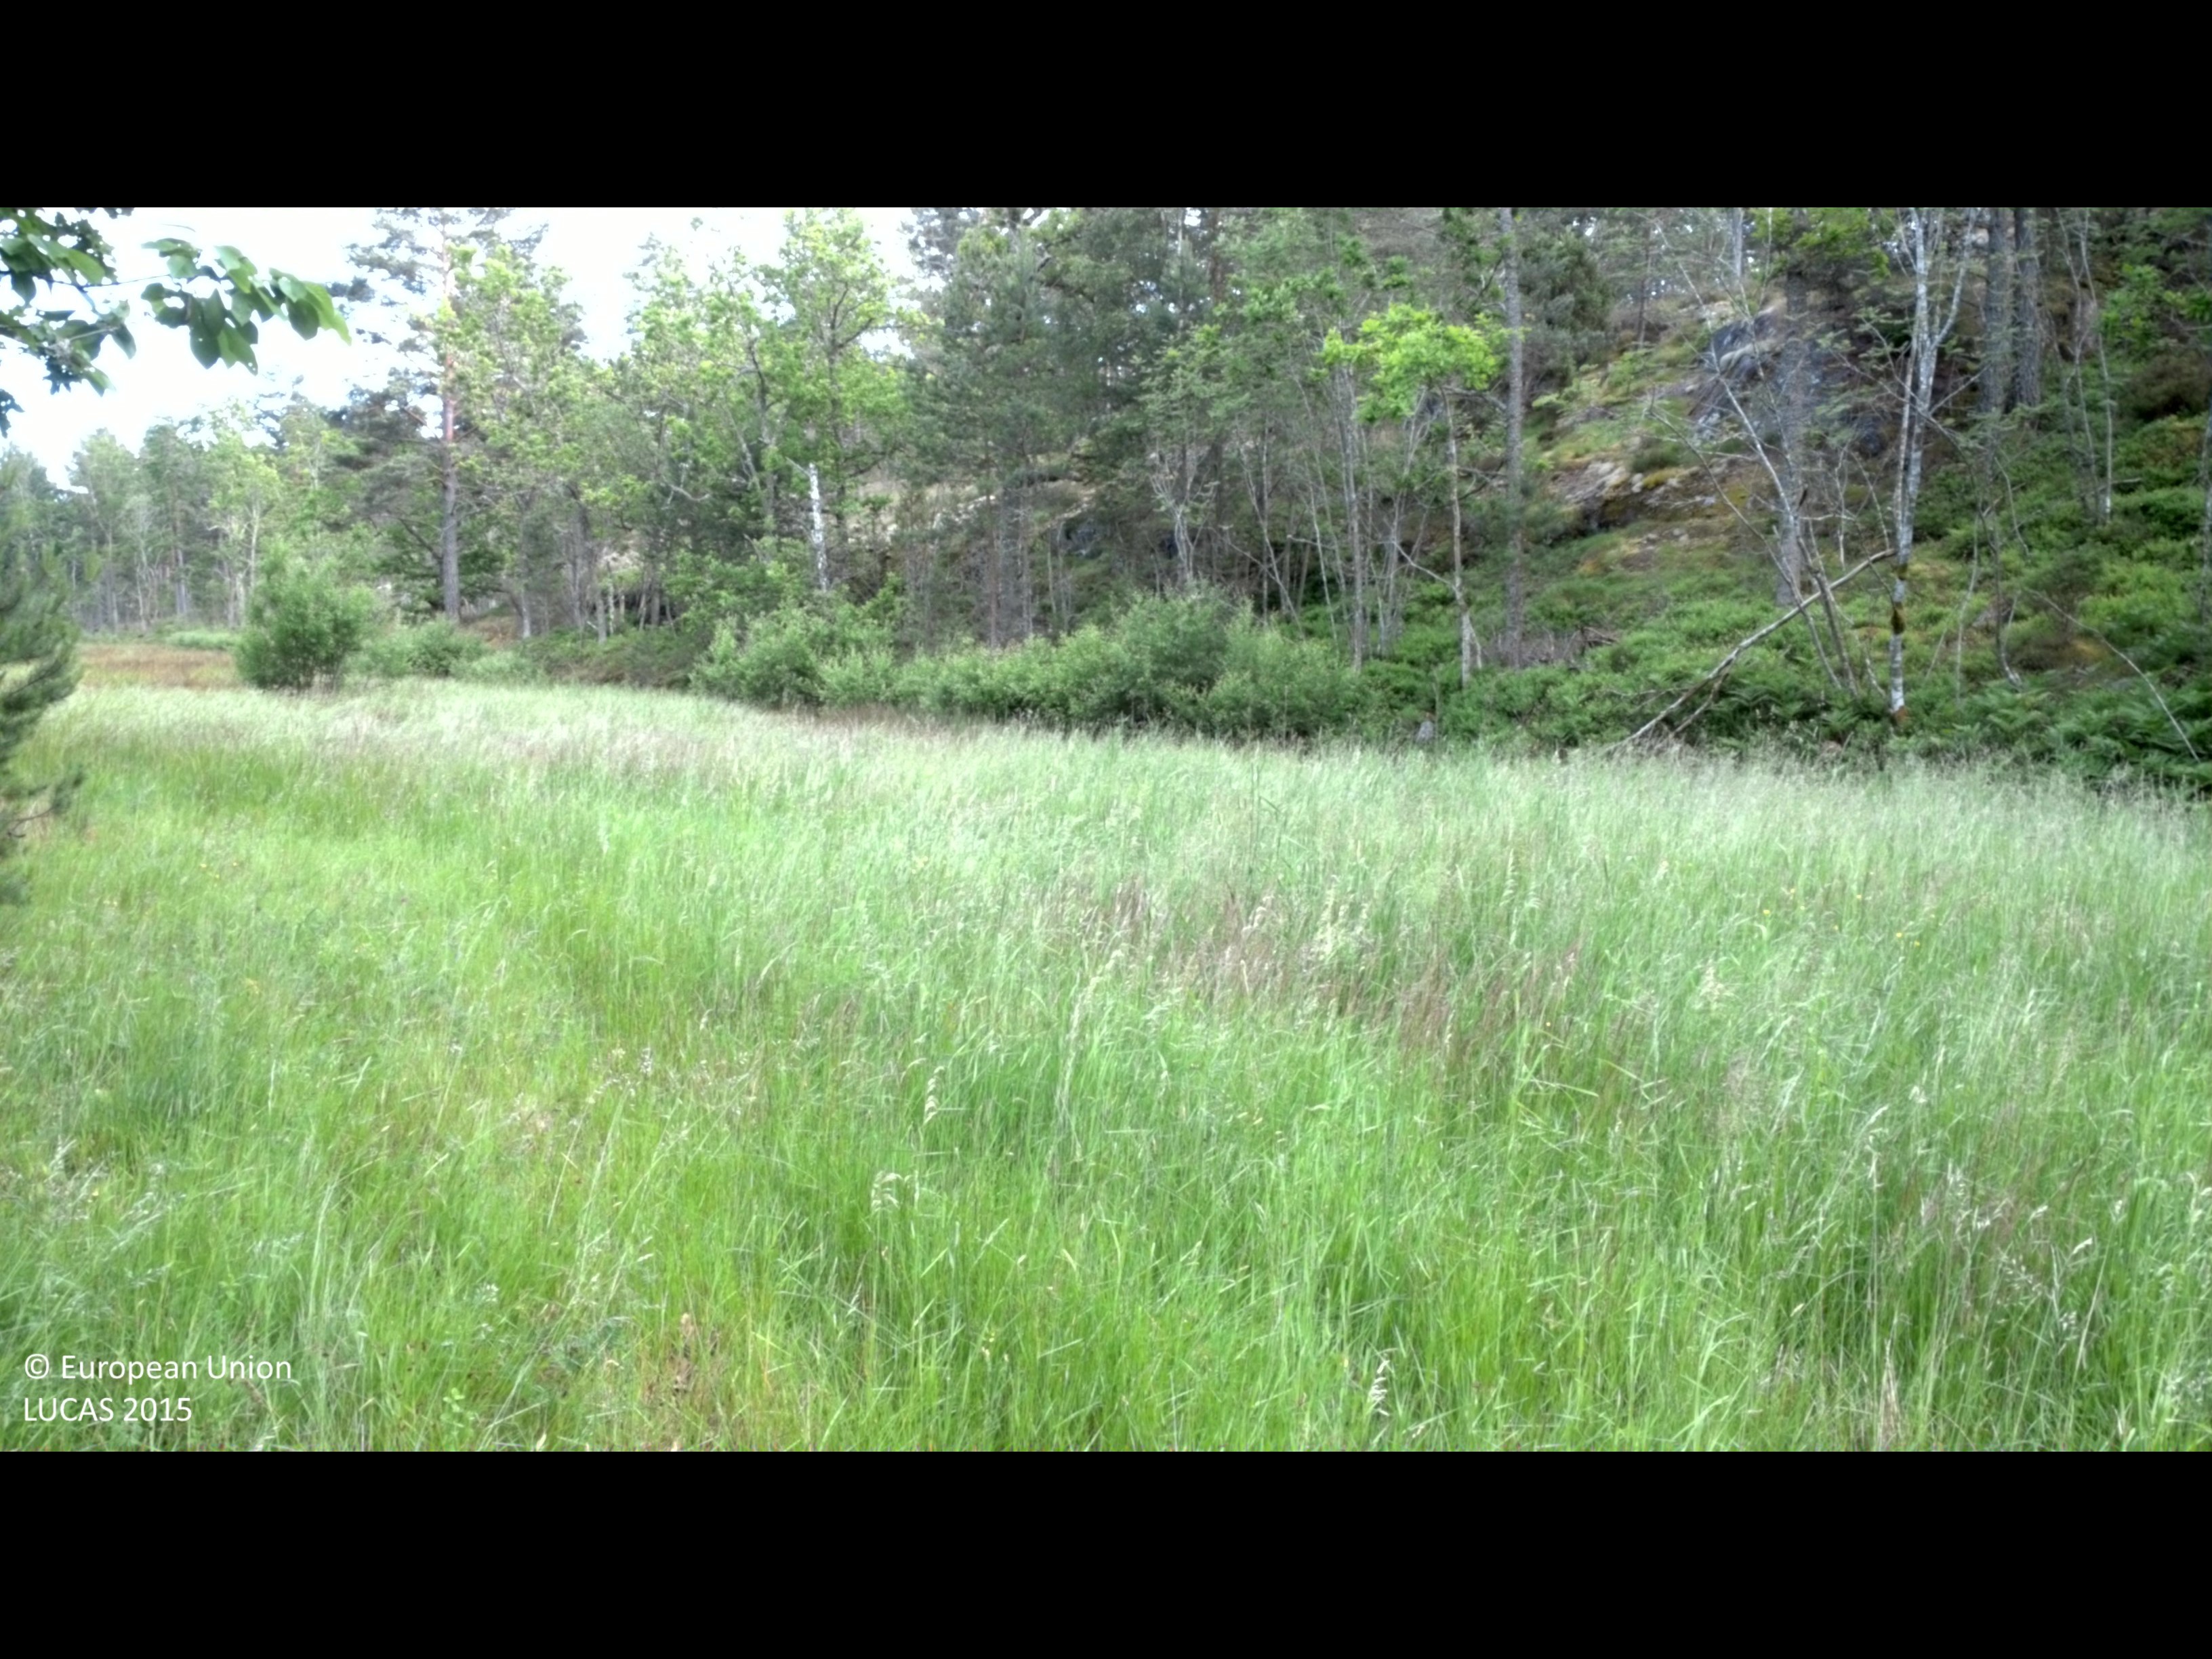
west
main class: Grassland
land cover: Grassland without tree/shrub cover
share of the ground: > 75 %
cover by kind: herbaceous plants 90 %, lichens and mosses 10 %
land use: Agriculture (excluding fallow land and kitchen gardens)
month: June
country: SE
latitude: 57.9975
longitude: 16.7148
